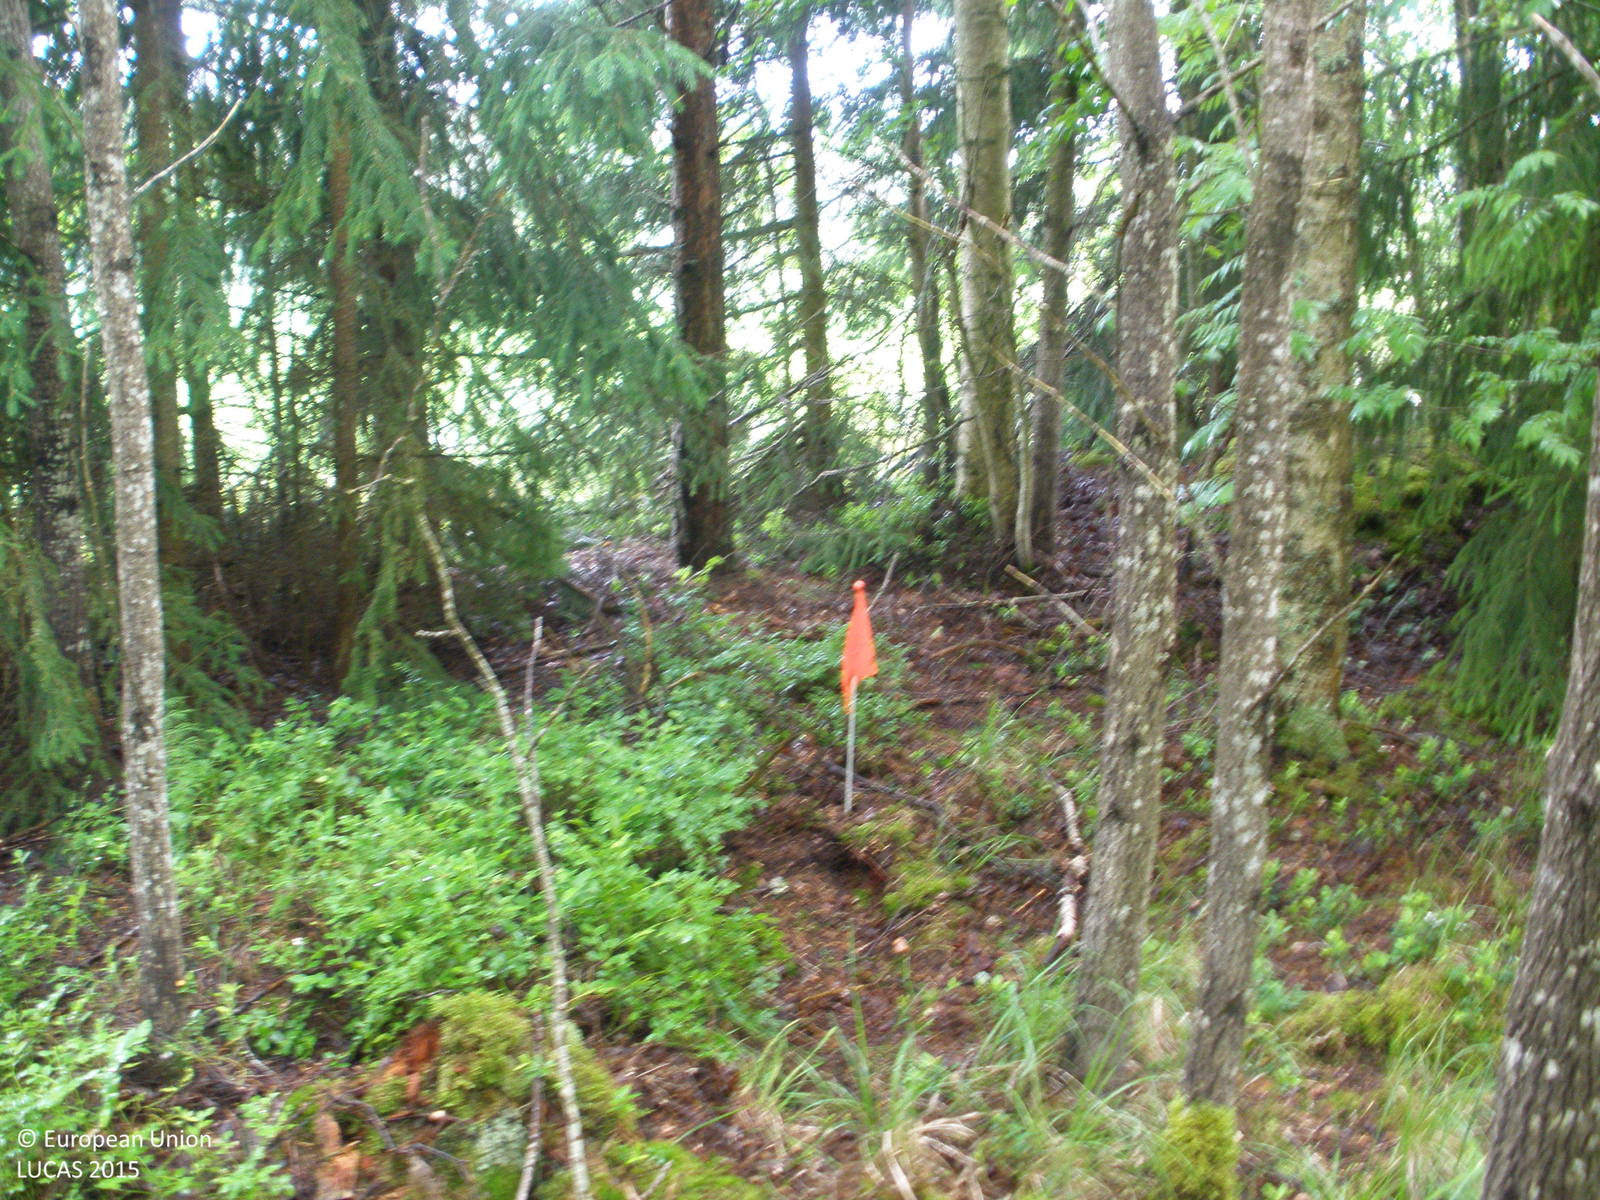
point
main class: Woodland
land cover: Spruce dominated mixed woodland
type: boreal forest
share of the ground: > 75 %
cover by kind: broadleaved forest trees 45 %, coniferous forest trees 40 %, herbaceous plants 10 %, lichens and mosses 5 %
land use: Forestry
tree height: > 5 m
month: June
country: FI
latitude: 60.8989
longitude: 23.5214
